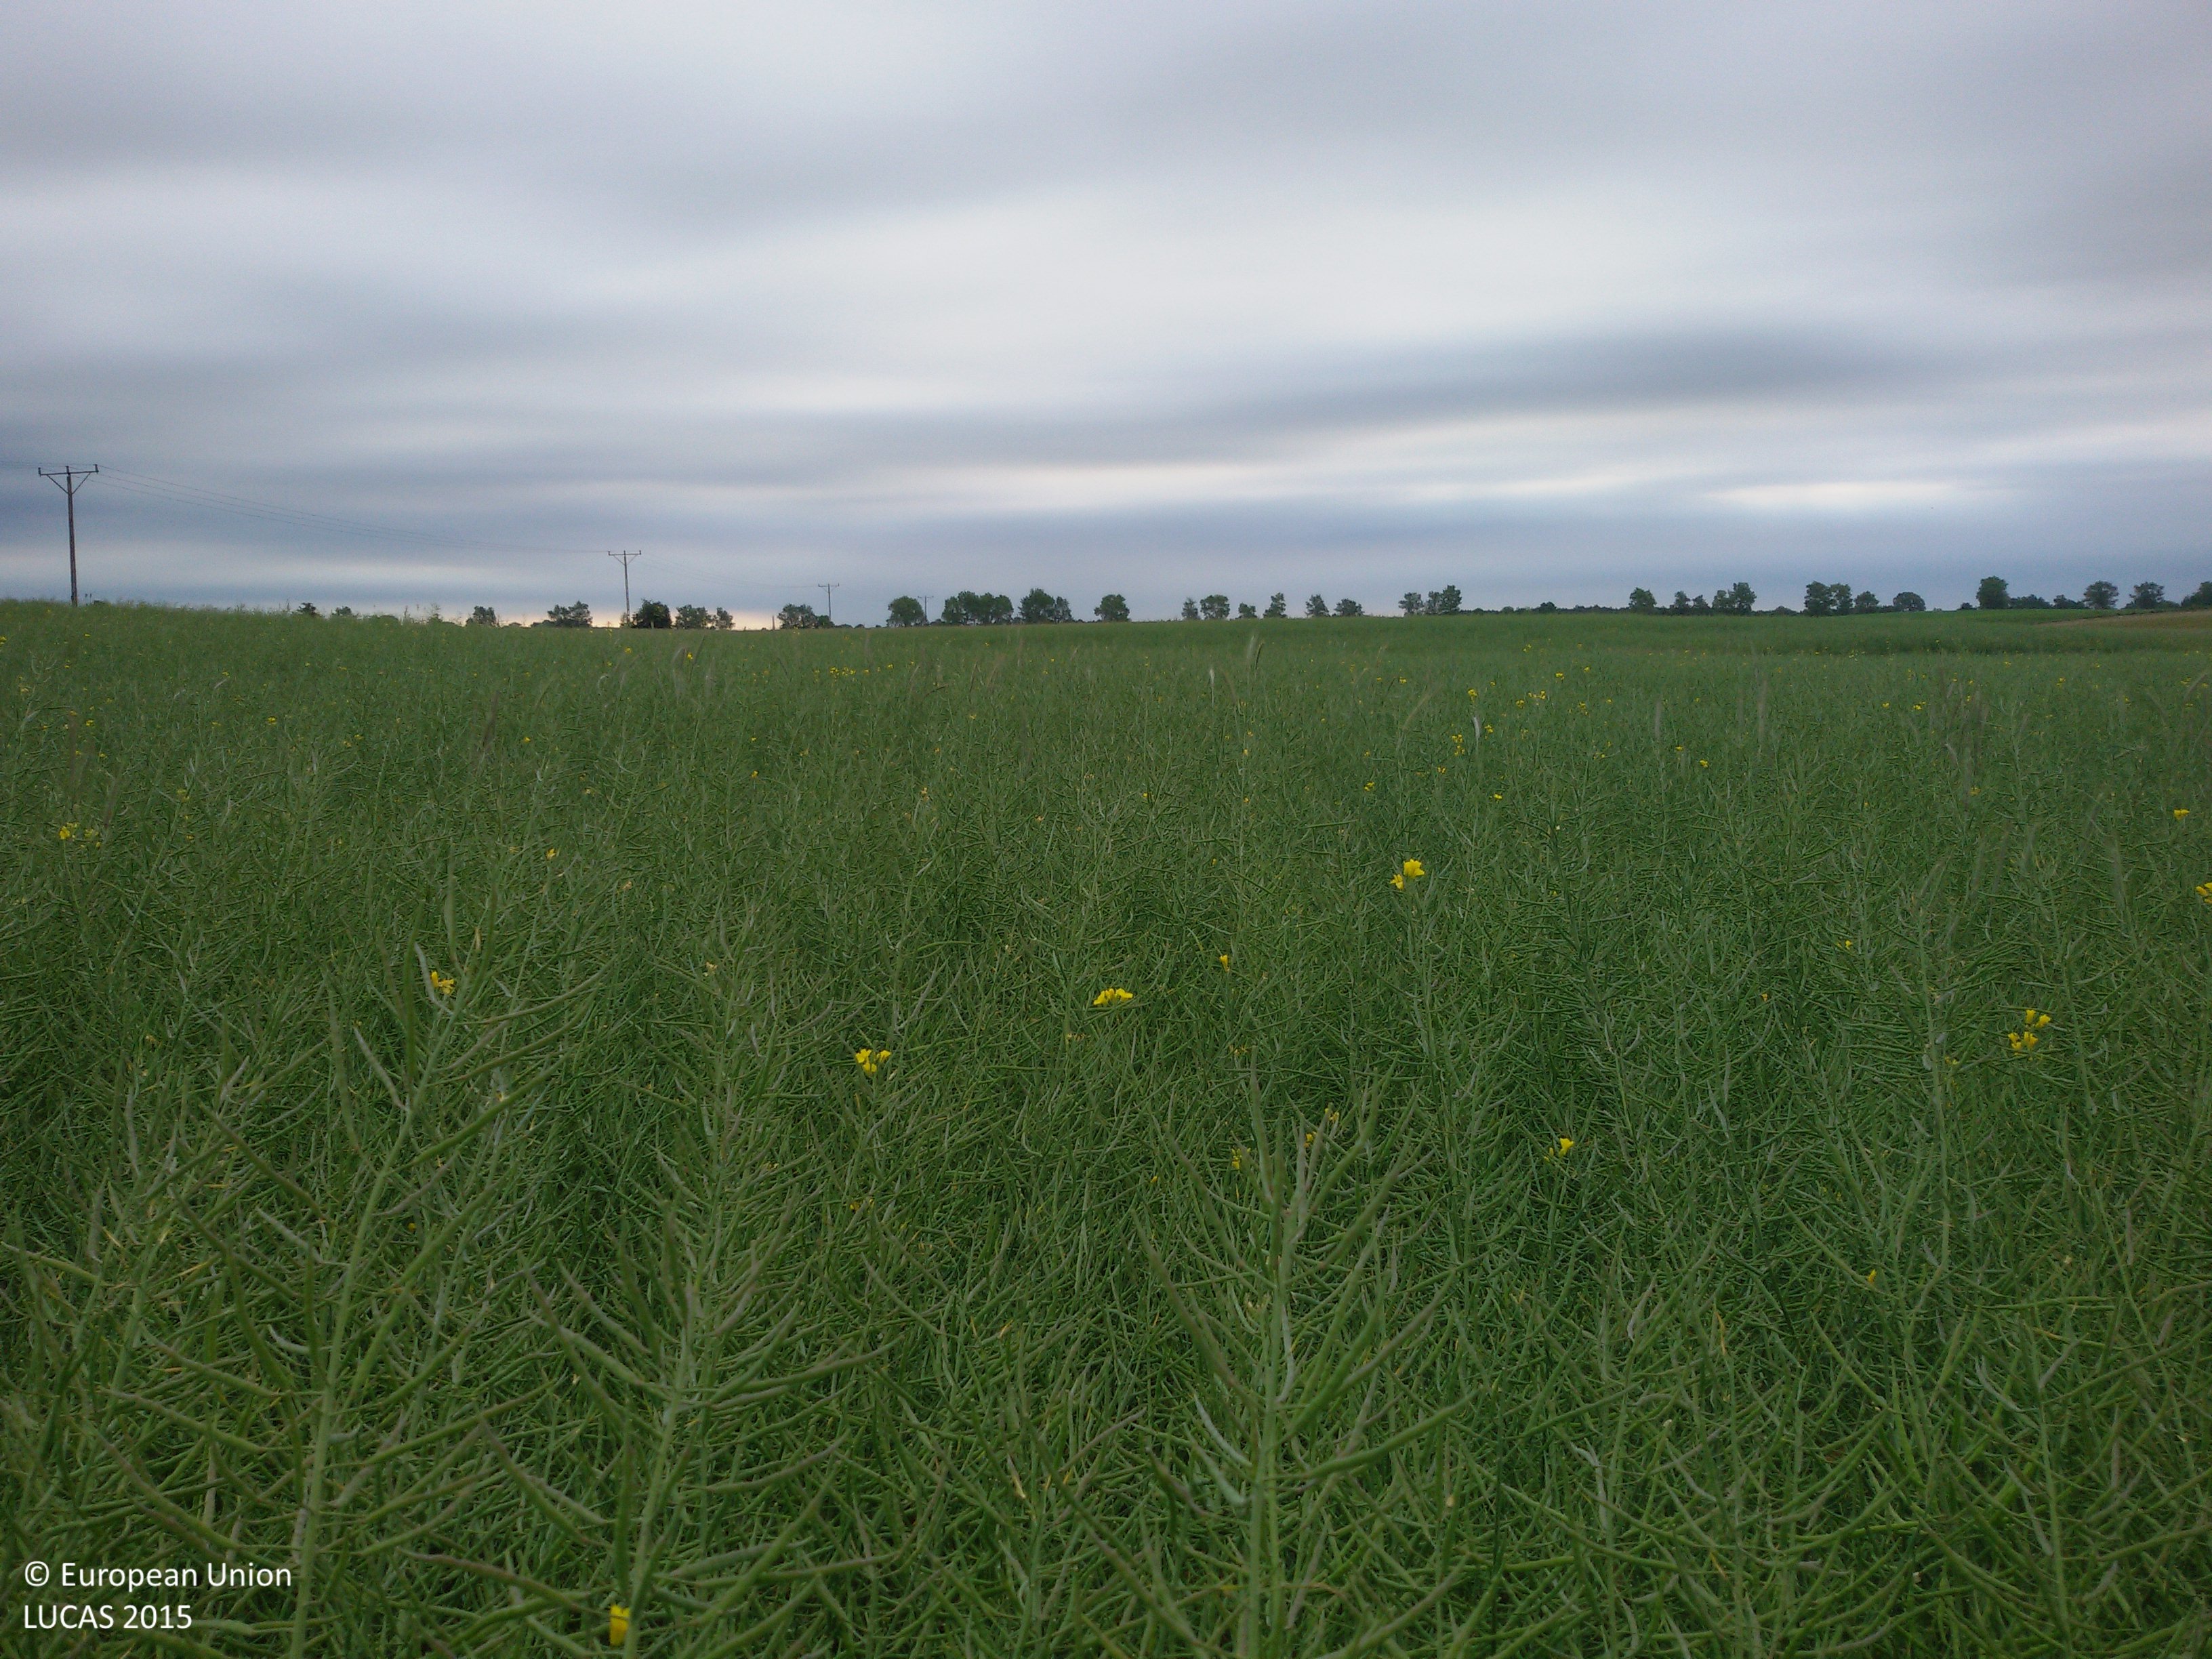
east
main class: Cropland
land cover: Rape and turnip rape
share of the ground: > 75 %
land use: Agriculture (excluding fallow land and kitchen gardens)
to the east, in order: Rape and turnip rape; Triticale; Maize; Spontaneously vegetated surfaces; Barley
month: June
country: PL
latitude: 53.2112
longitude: 17.6947
